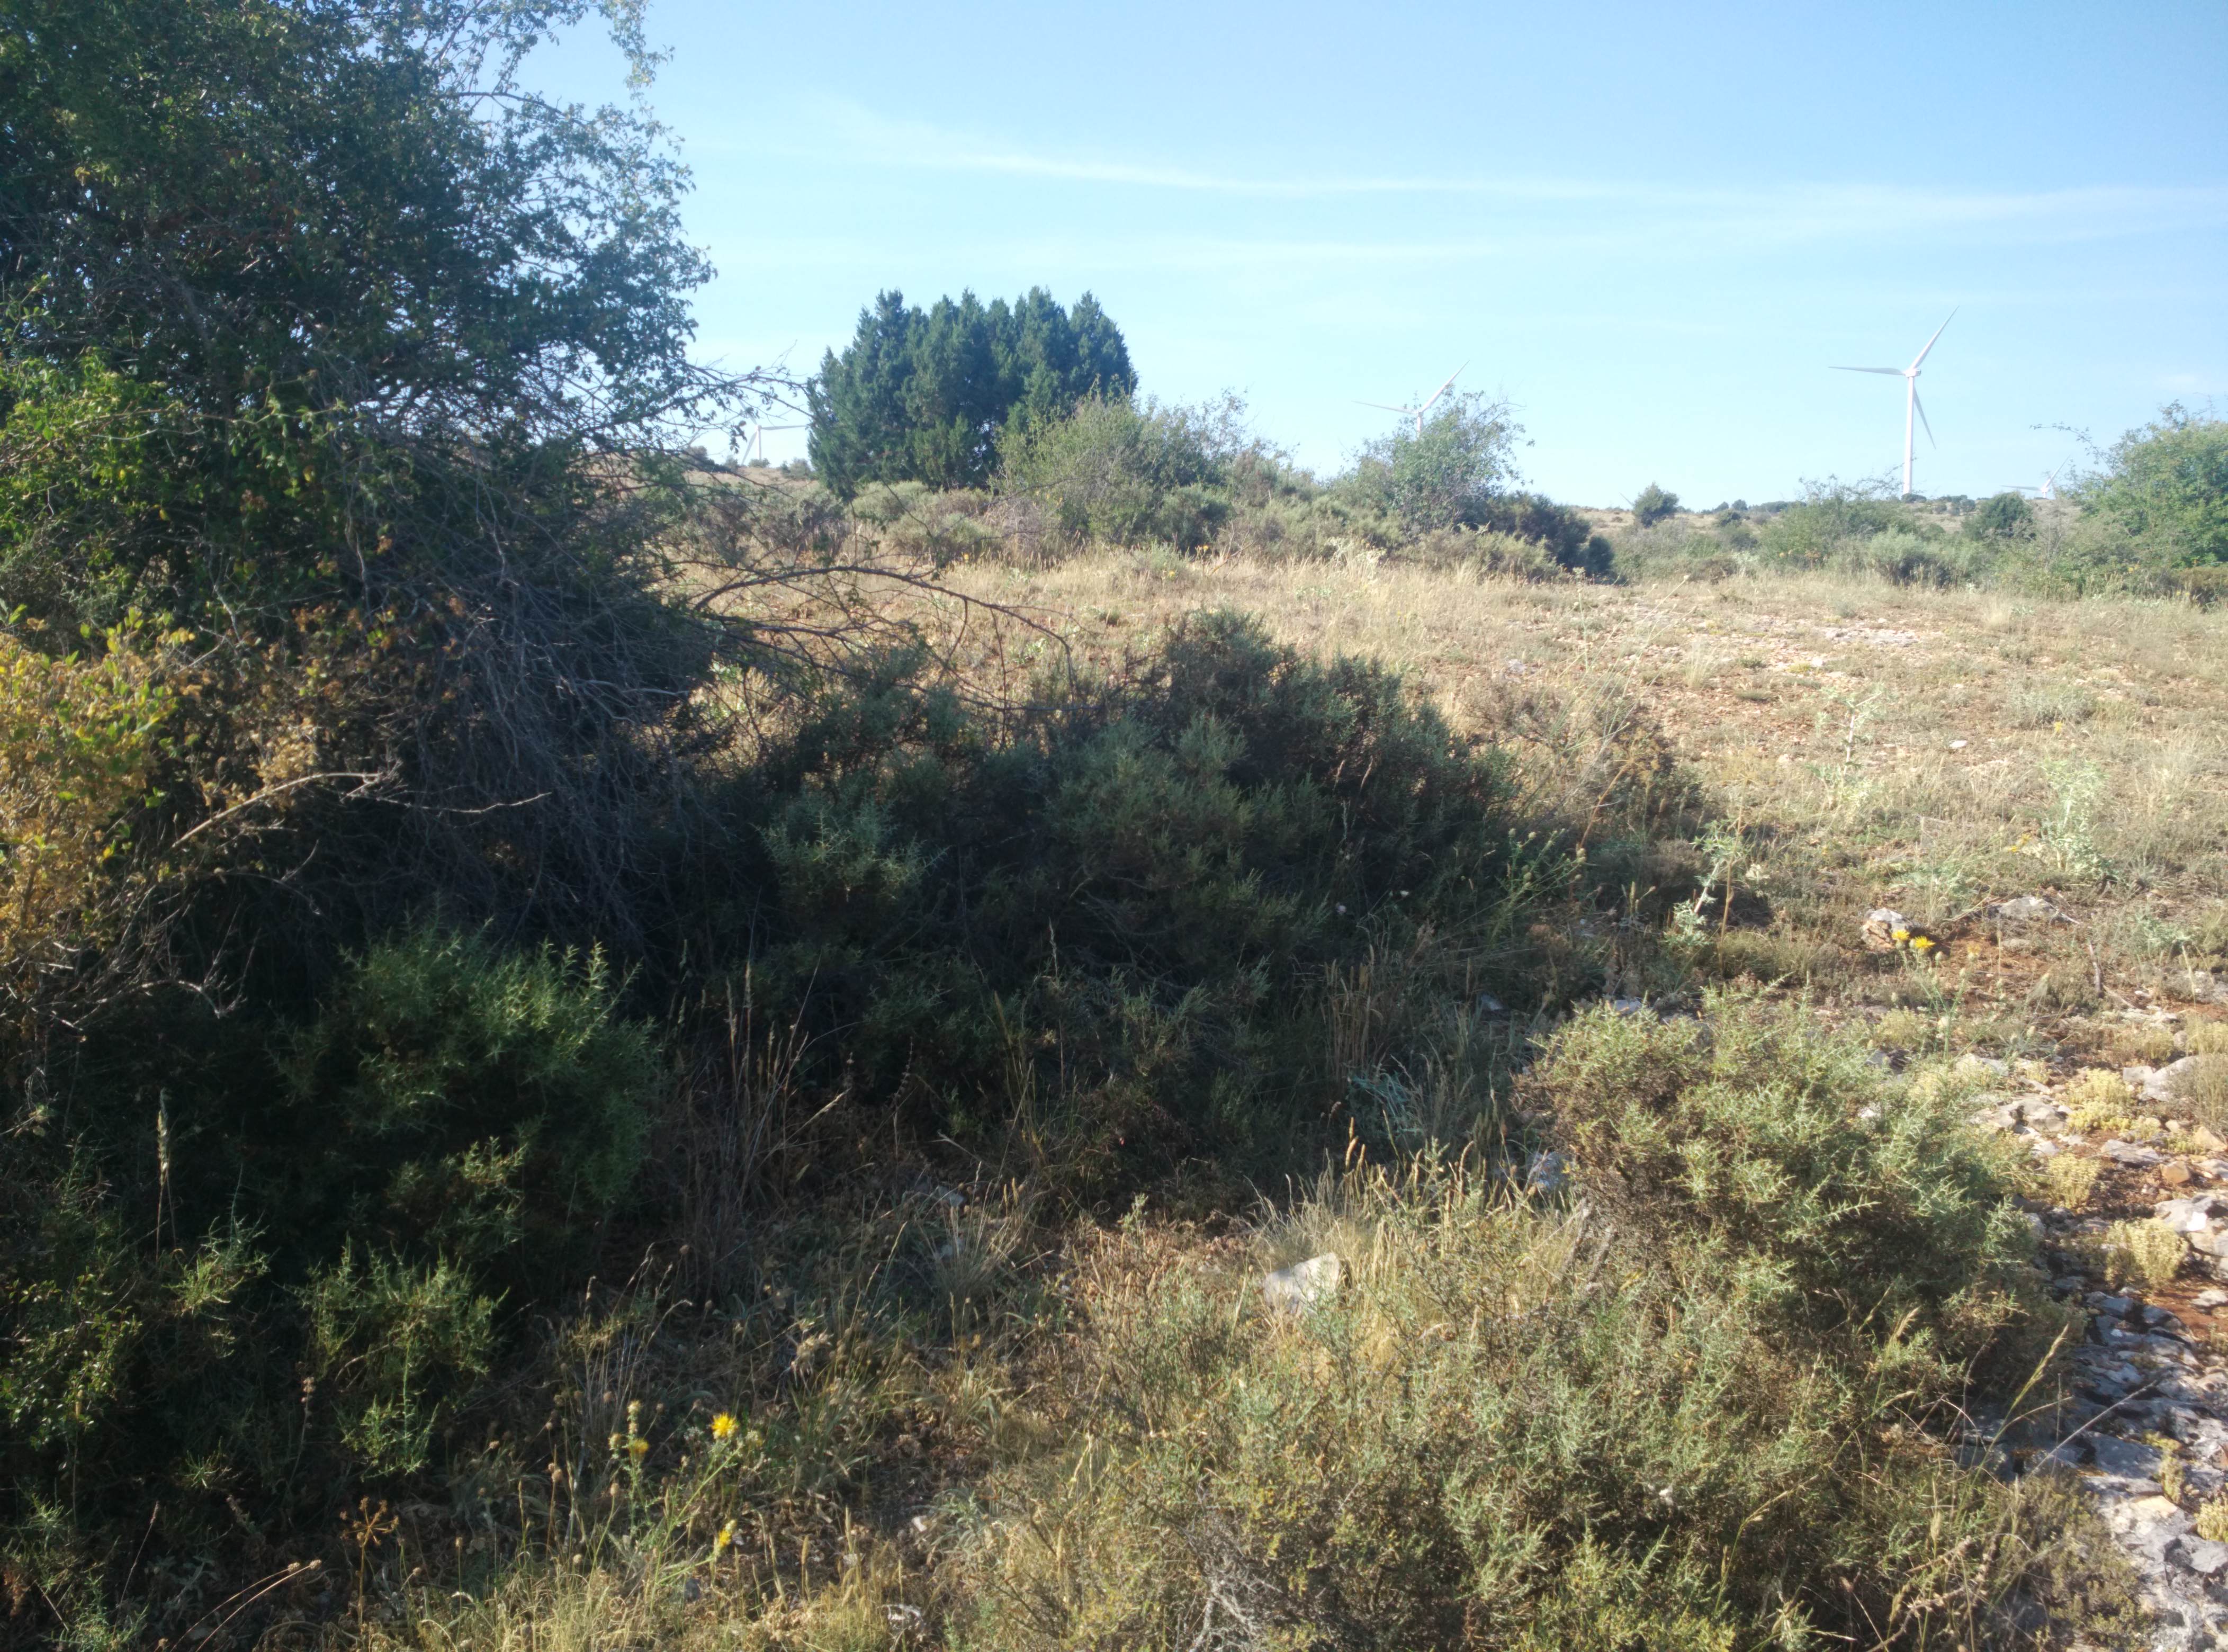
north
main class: Shrubland
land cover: Shrubland without tree cover
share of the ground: 10 - 25 %
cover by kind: unconsolidated bare surface 45 %, shrubs 20 %, herbaceous plants 10 %
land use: Semi-natural and natural areas not in use
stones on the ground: 10 - 25 %
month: July
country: ES
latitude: 41.0081
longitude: -2.1423
